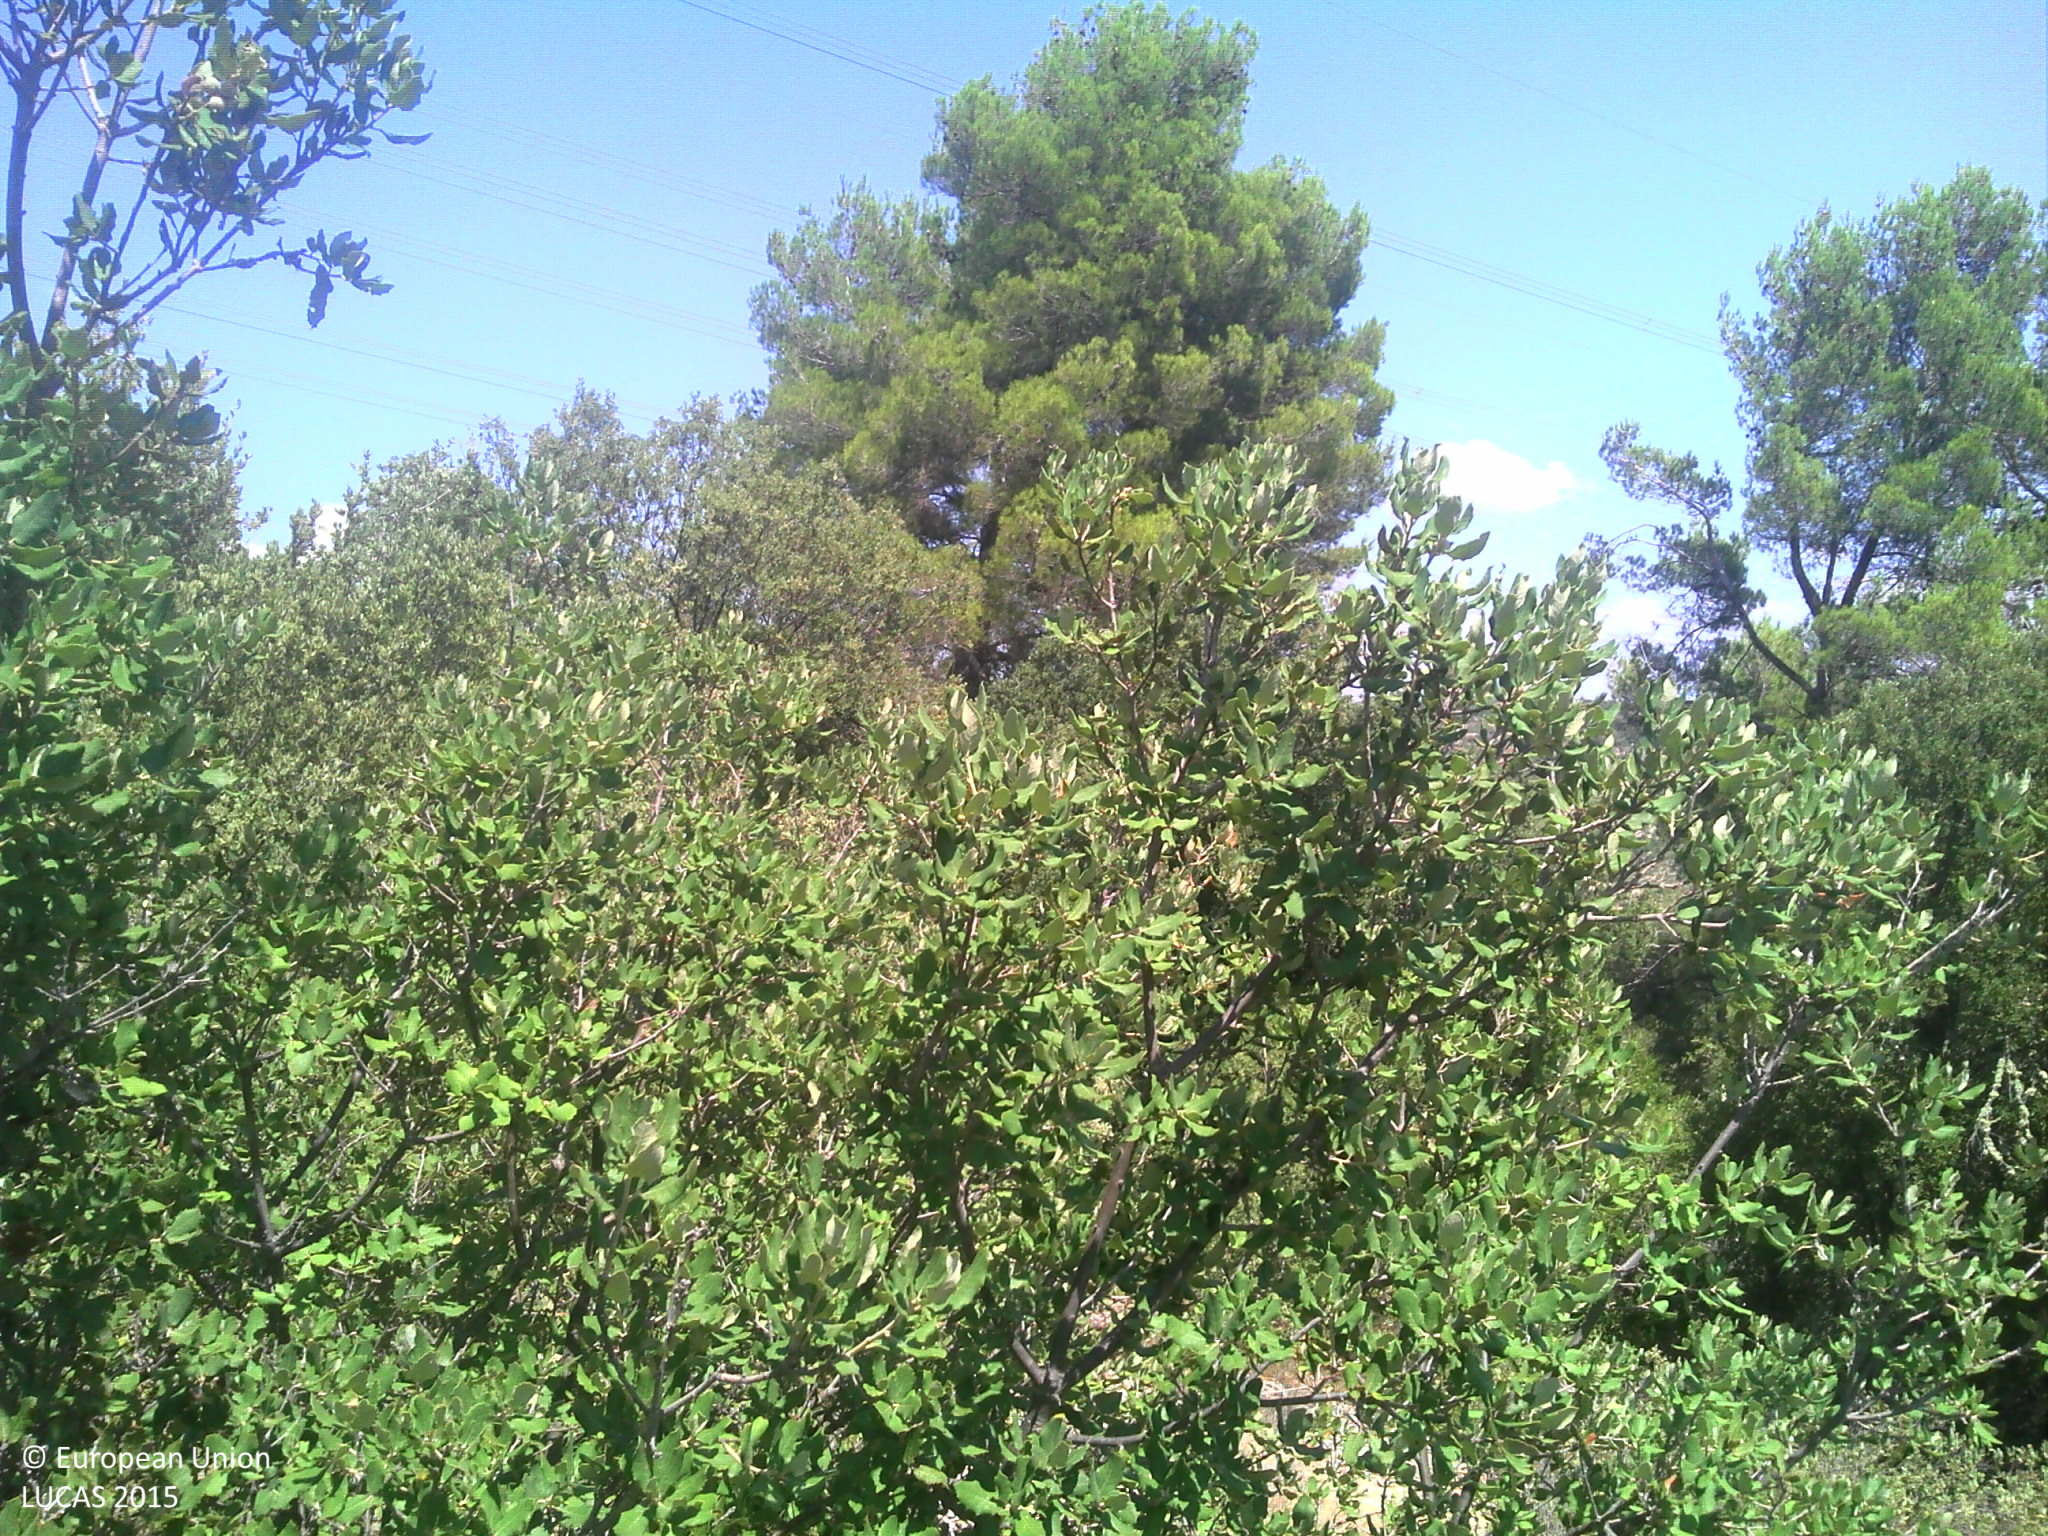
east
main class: Shrubland
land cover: Shrubland with sparse tree cover
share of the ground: > 75 %
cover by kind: shrubs 40 %, herbaceous plants 25 %, unconsolidated bare surface 25 %, broadleaved forest trees 5 %, consolidated bare surface 5 %
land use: Forestry
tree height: < 5 m
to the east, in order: Shrubland with sparse tree cover; Pine dominated mixed woodland; Electric lines; Tracks; Pine dominated mixed woodland; Rocks and stones; Shrubland without tree cover; Pine dominated coniferous woodland; Tracks; Broadleaved woodland
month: August
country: FR
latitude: 43.6666
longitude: 5.7305
